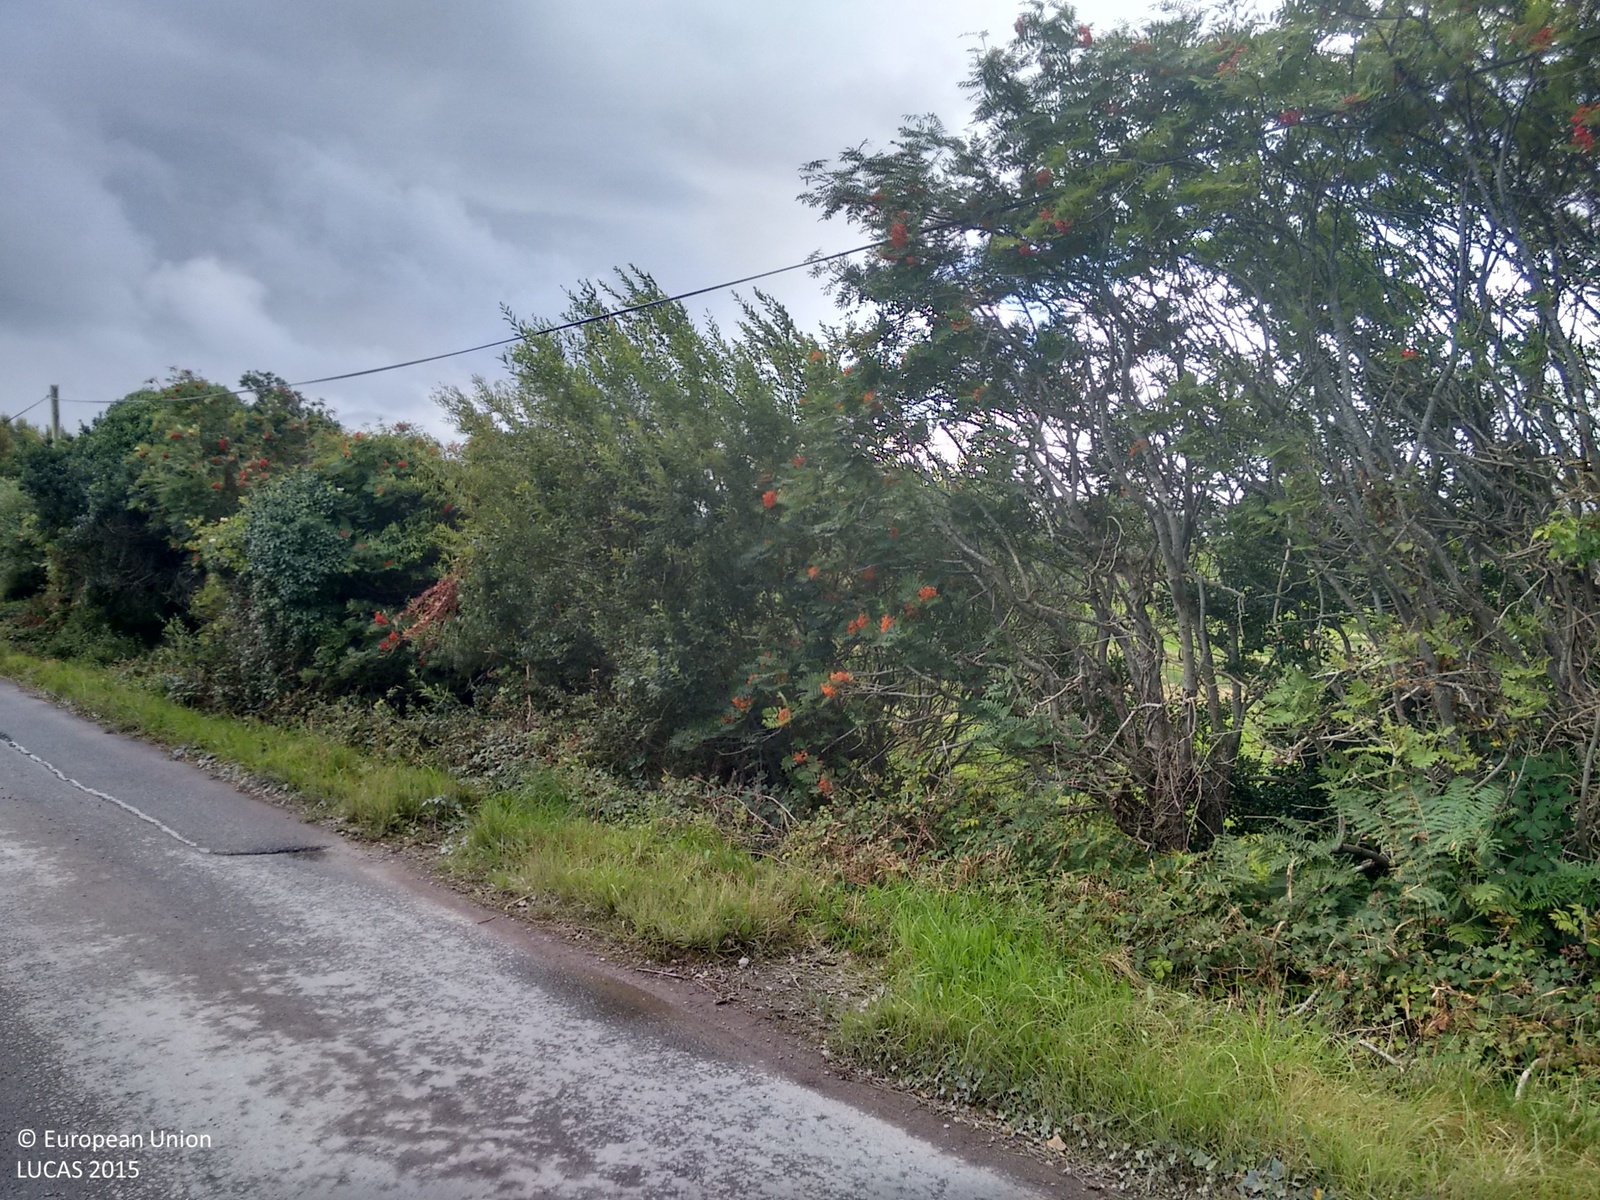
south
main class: Grassland
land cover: Grassland without tree/shrub cover
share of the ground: > 75 %
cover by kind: herbaceous plants 100 %
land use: Agriculture (excluding fallow land and kitchen gardens)
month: August
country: IE
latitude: 52.0858
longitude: -9.8470
